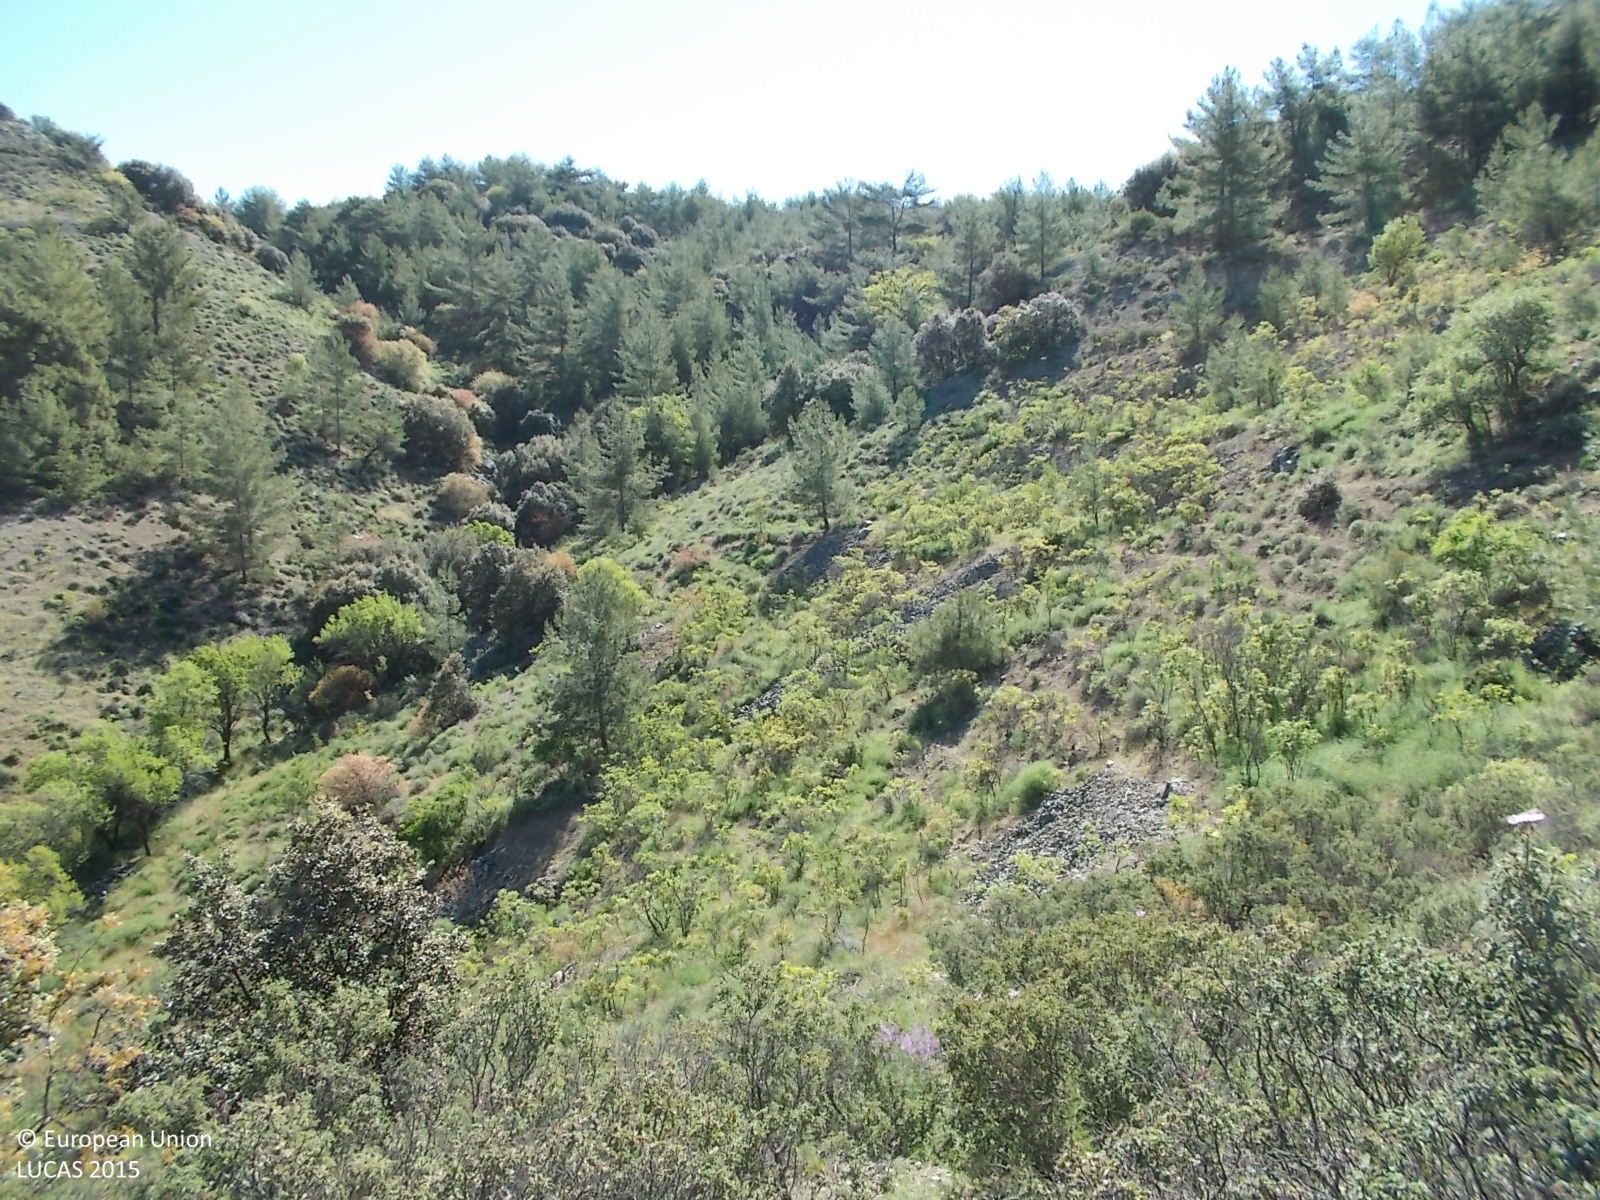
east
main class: Shrubland
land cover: Shrubland with sparse tree cover
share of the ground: > 75 %
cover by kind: shrubs 95 %, broadleaved forest trees 5 %
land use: Semi-natural and natural areas not in use
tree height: < 5 m
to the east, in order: Shrubland with sparse tree cover; Pine dominated coniferous woodland; Vineyards; Pine dominated coniferous woodland
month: May
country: CY
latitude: 34.8810
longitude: 33.0265
